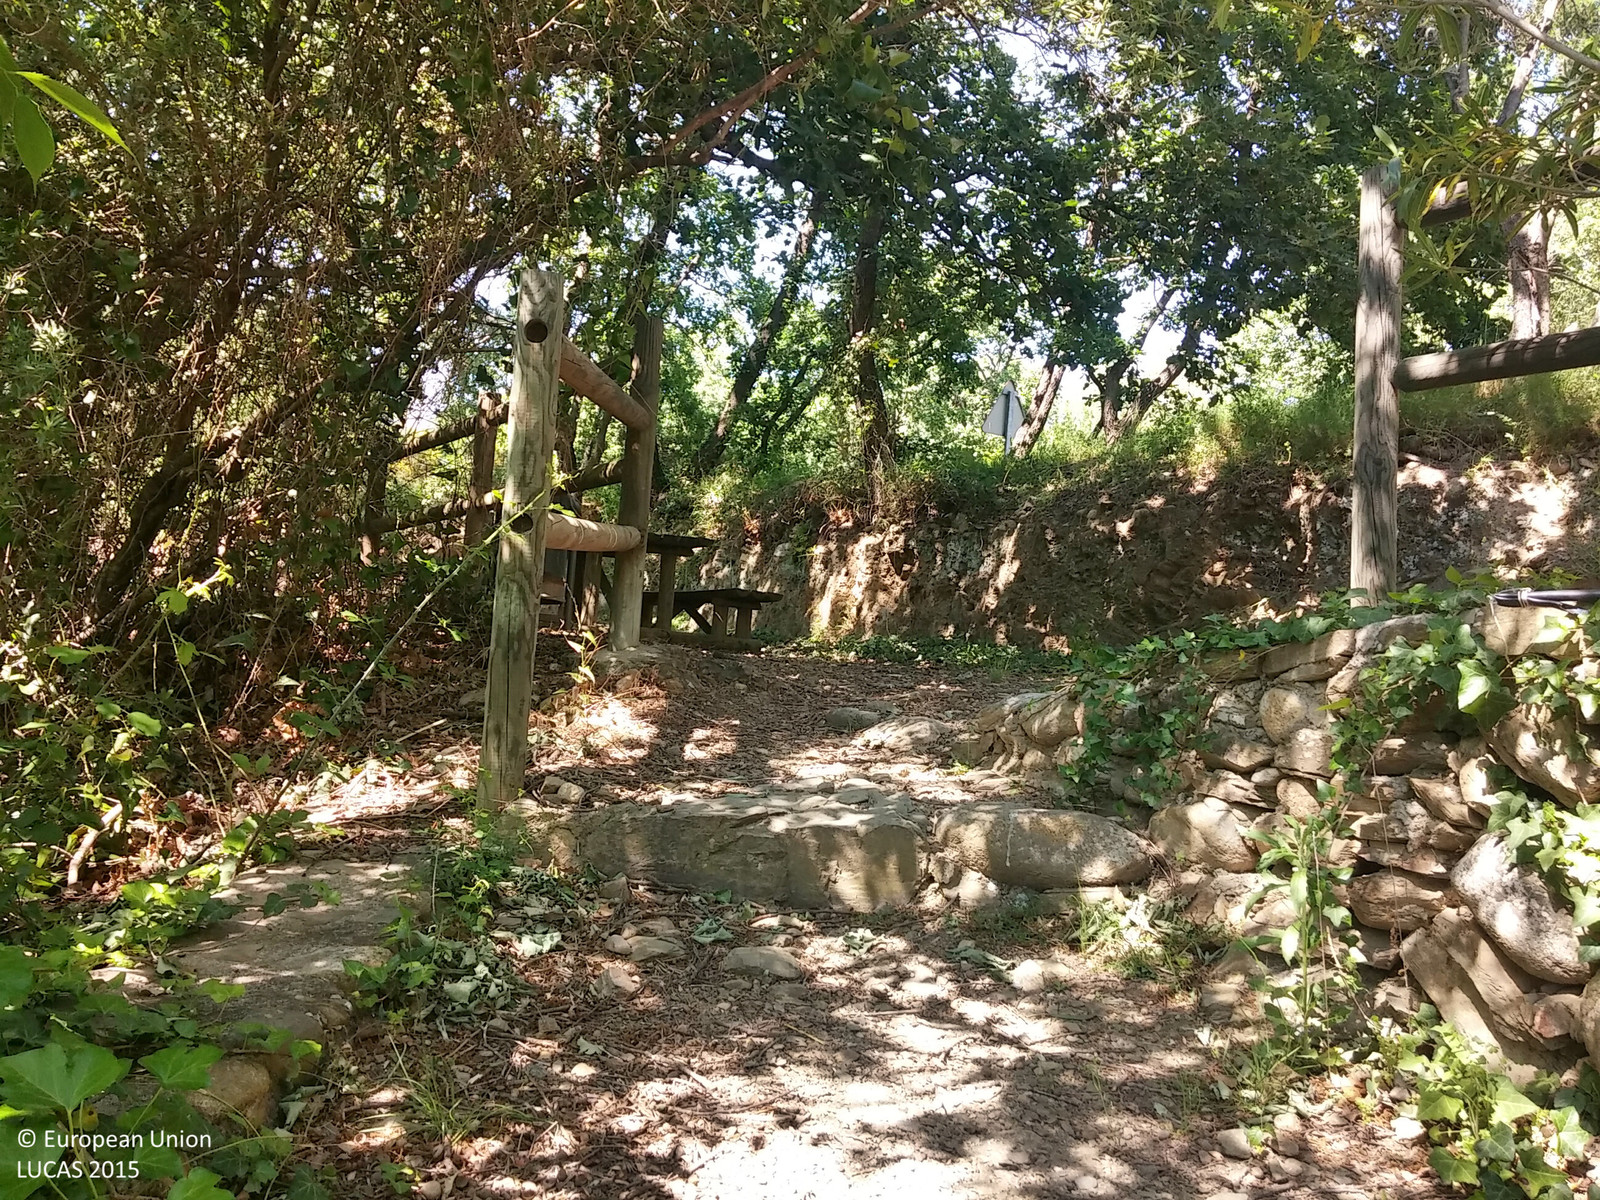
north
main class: Woodland
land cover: Broadleaved woodland
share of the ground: 50 - 75 %
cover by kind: broadleaved forest trees 65 %, shrubs 30 %
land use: Semi-natural and natural areas not in use
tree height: > 5 m
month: May
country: ES
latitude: 42.3775
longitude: 3.0305
